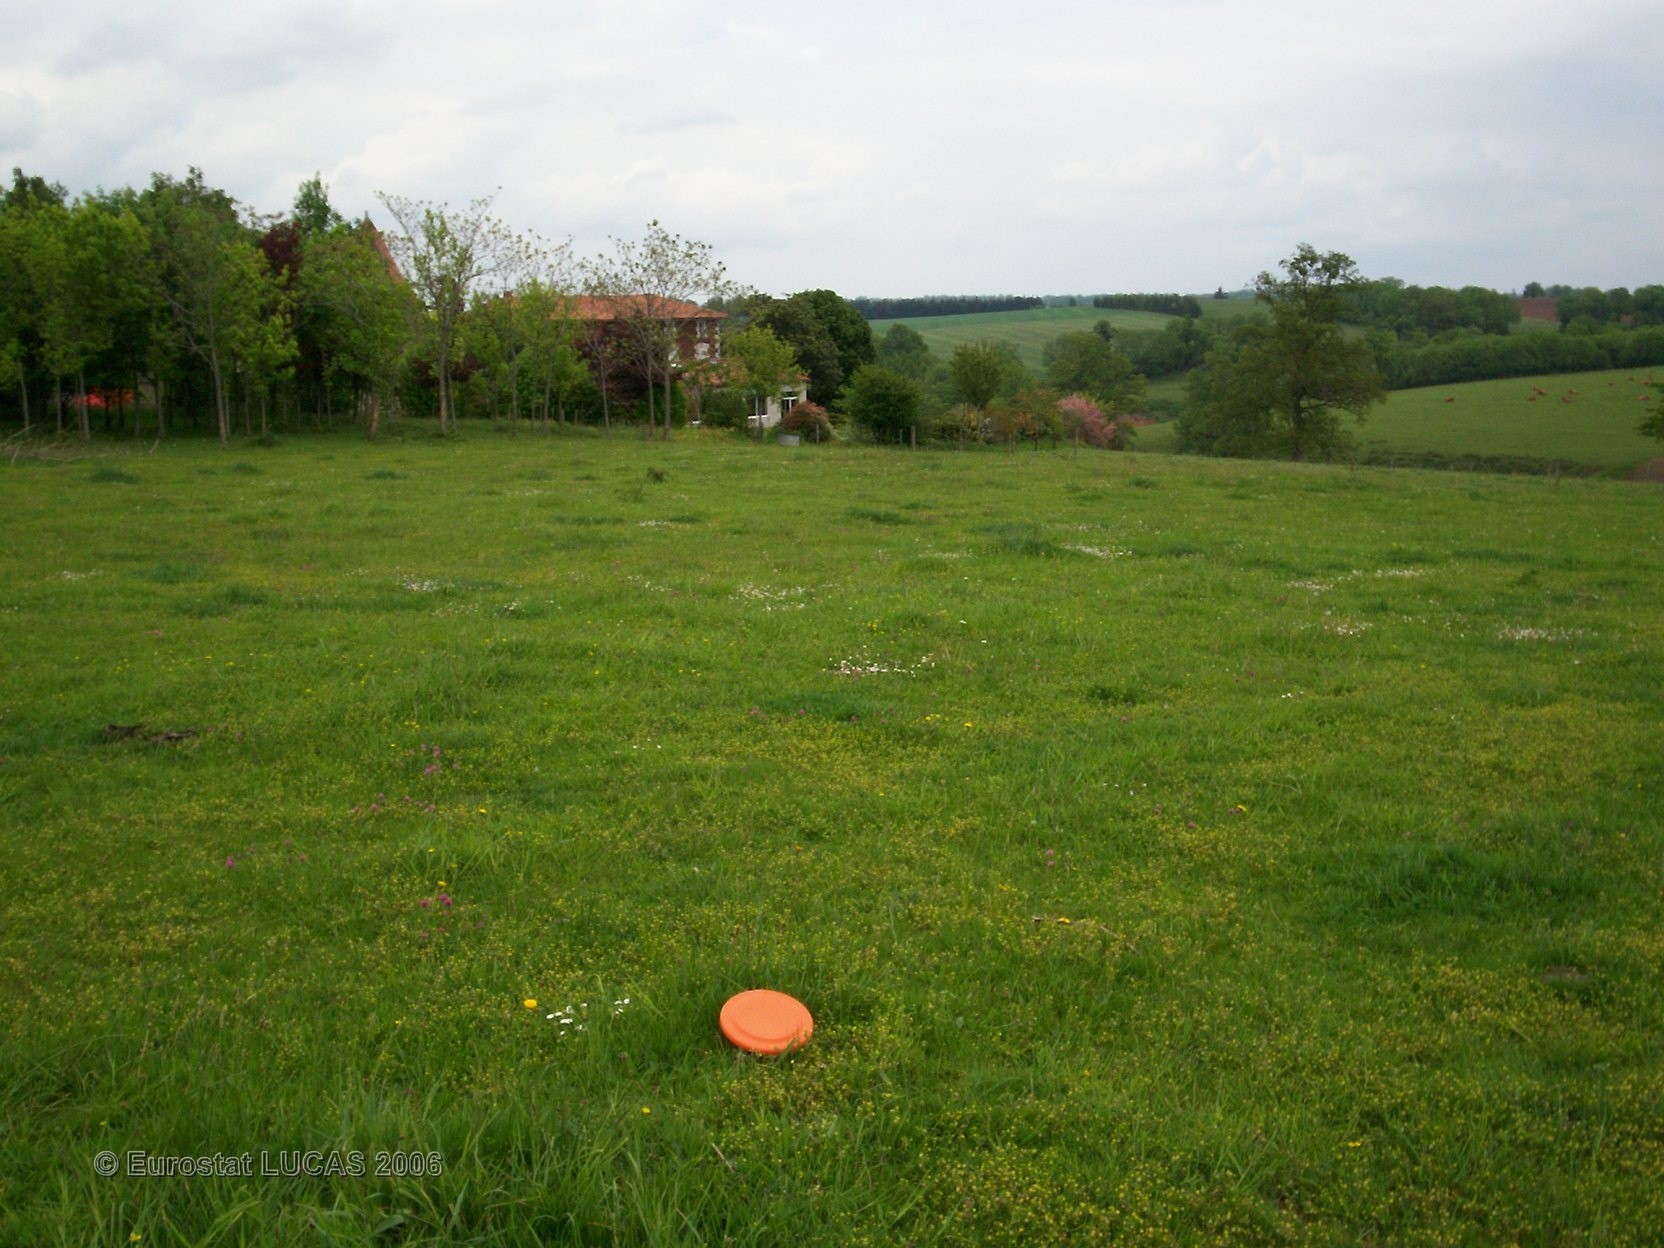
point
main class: Grassland
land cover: Grassland without tree/shrub cover
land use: Agriculture (excluding fallow land and kitchen gardens)
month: May
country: FR
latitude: 45.7697
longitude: 0.5604
